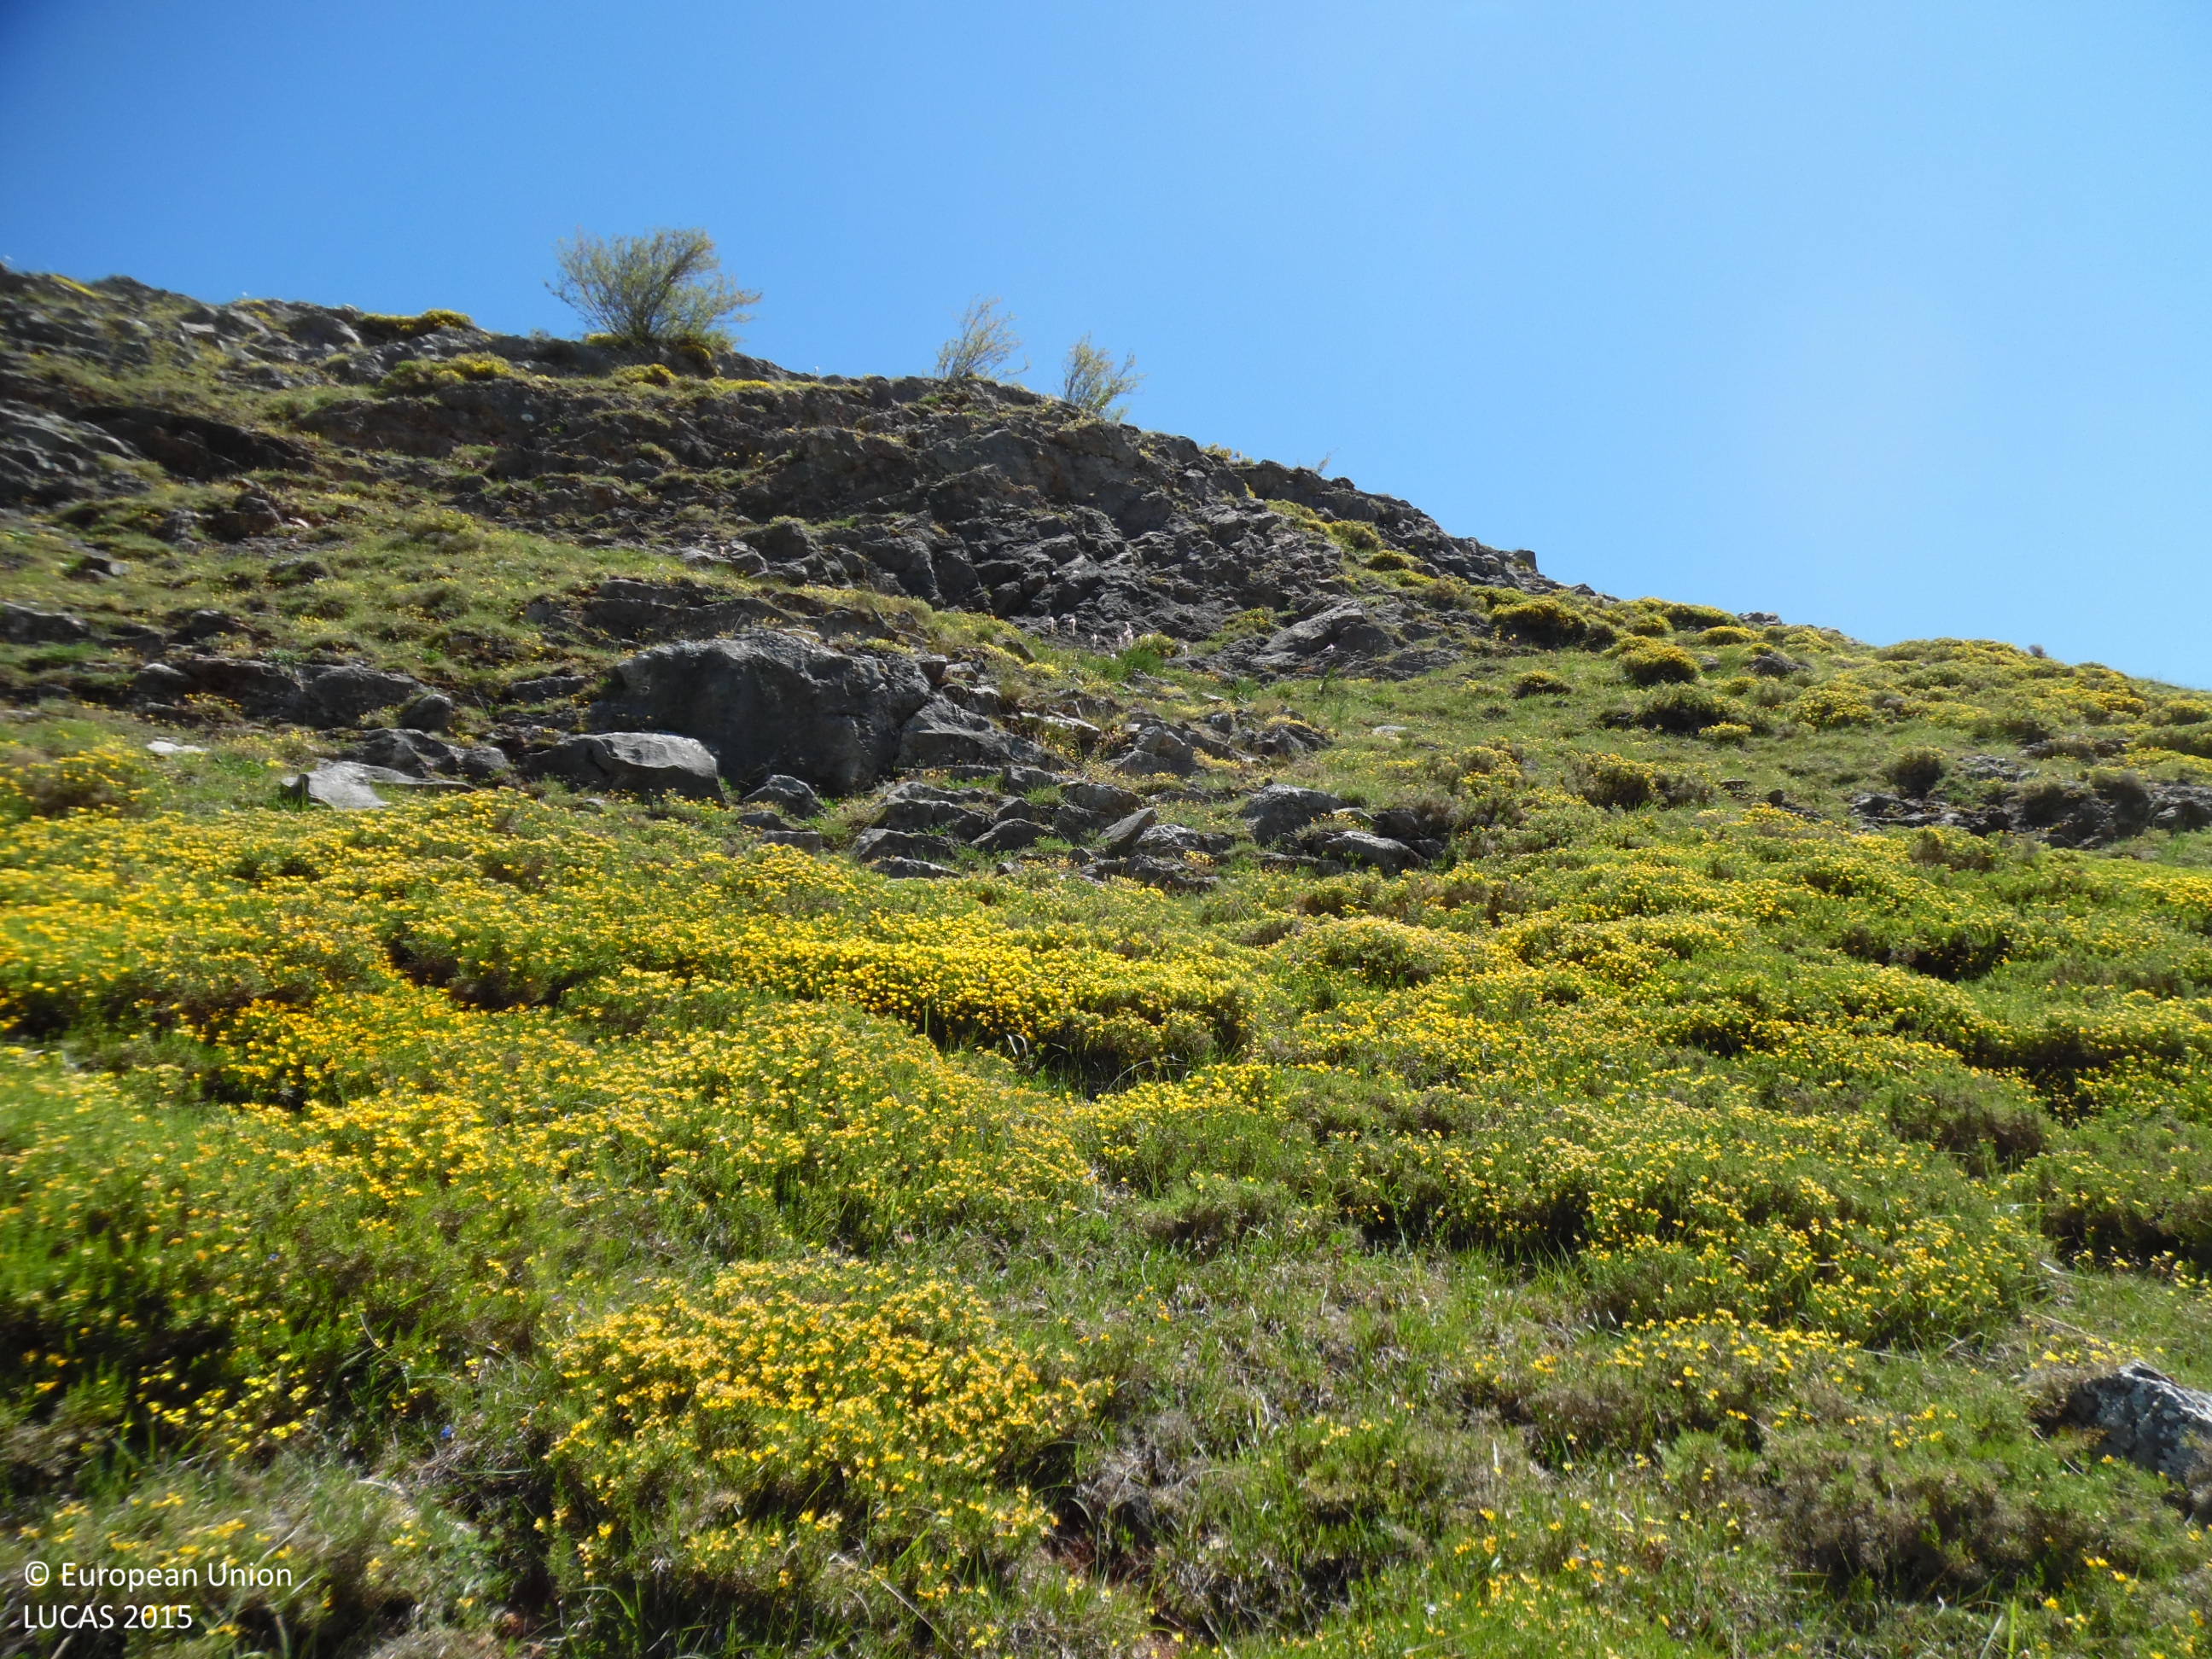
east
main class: Shrubland
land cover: Shrubland without tree cover
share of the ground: > 75 %
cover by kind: shrubs 90 %, herbaceous plants 10 %
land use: Semi-natural and natural areas not in use
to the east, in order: Shrubland without tree cover; Rocks and stones; Grassland with sparse tree/shrub cover; Rocks and stones; Shrubland without tree cover; Tracks; Shrubland without tree cover; Dry stone walls; Shrubland without tree cover; Groves; Grassland with sparse tree/shrub cover; Lines of trees; Fences; Inland fresh running water; Lines of trees; Fences; Grassland with sparse tree/shrub cover
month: May
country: ES
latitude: 42.9730
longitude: -6.2152
